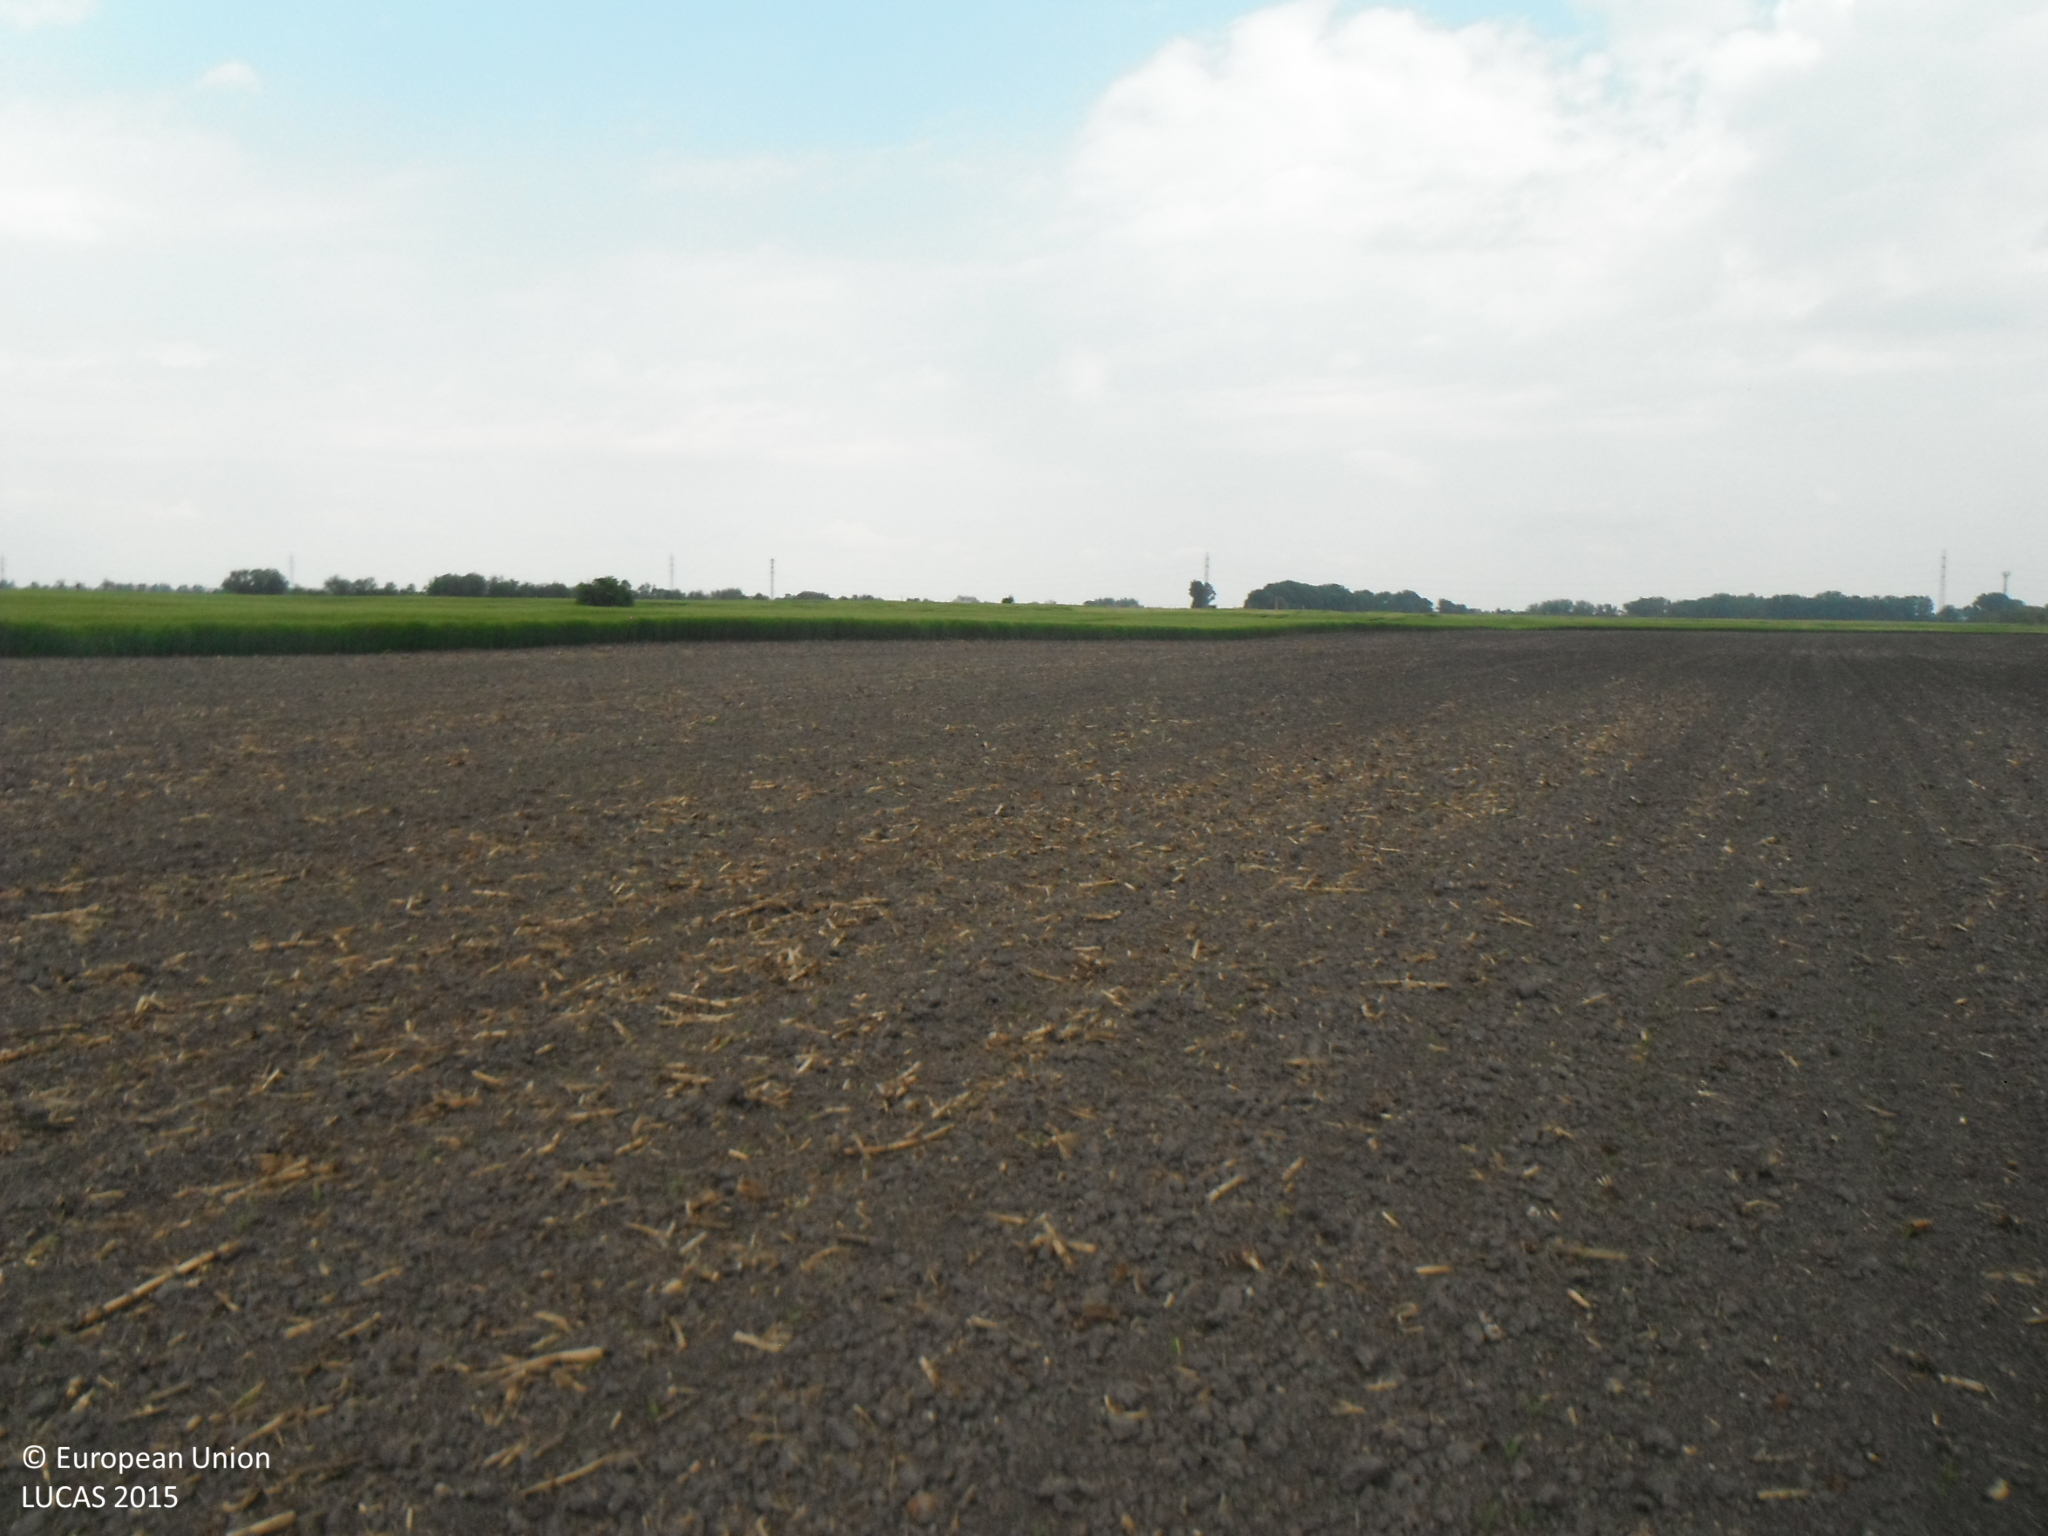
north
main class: Cropland
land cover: Maize
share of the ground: < 10 %
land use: Agriculture (excluding fallow land and kitchen gardens)
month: May
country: SK
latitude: 47.9589
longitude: 17.6301
